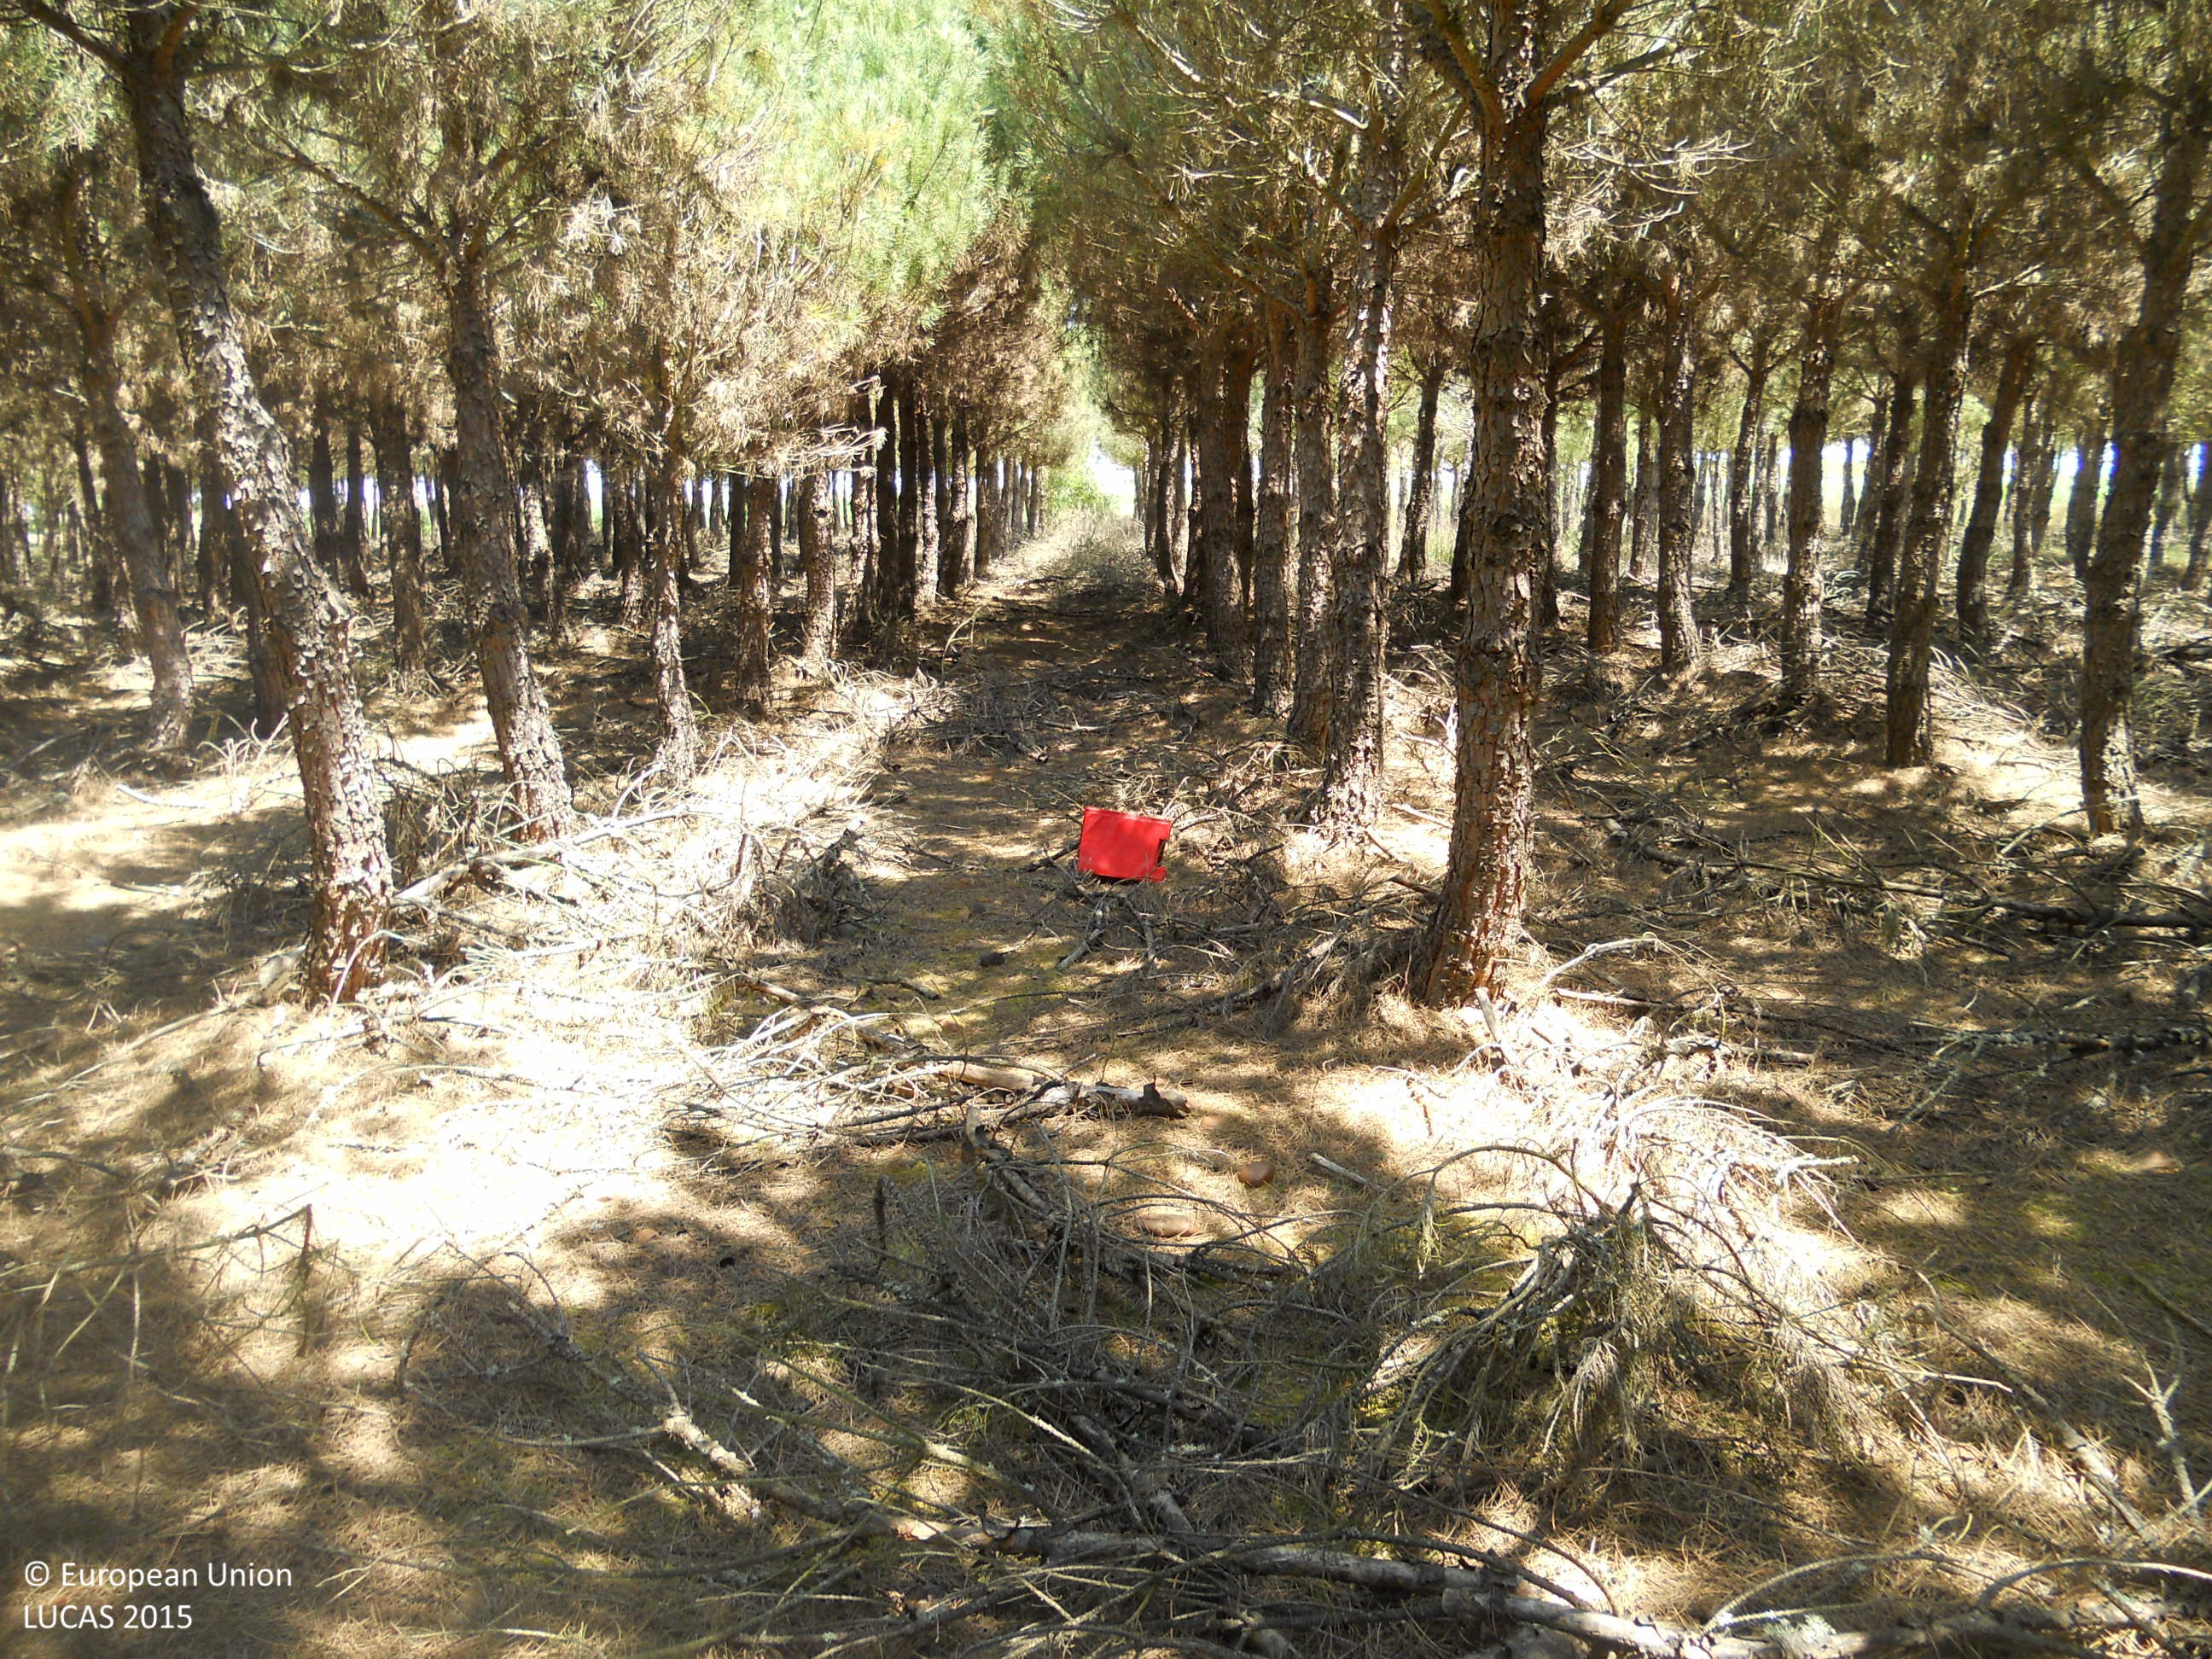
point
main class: Woodland
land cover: Pine dominated coniferous woodland
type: coniferous forest of the mediterranean region
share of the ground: > 75 %
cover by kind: coniferous forest trees 95 %, unconsolidated bare surface 5 %
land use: Forestry
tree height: < 5 m
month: June
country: ES
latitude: 42.3298
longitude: -5.6410
